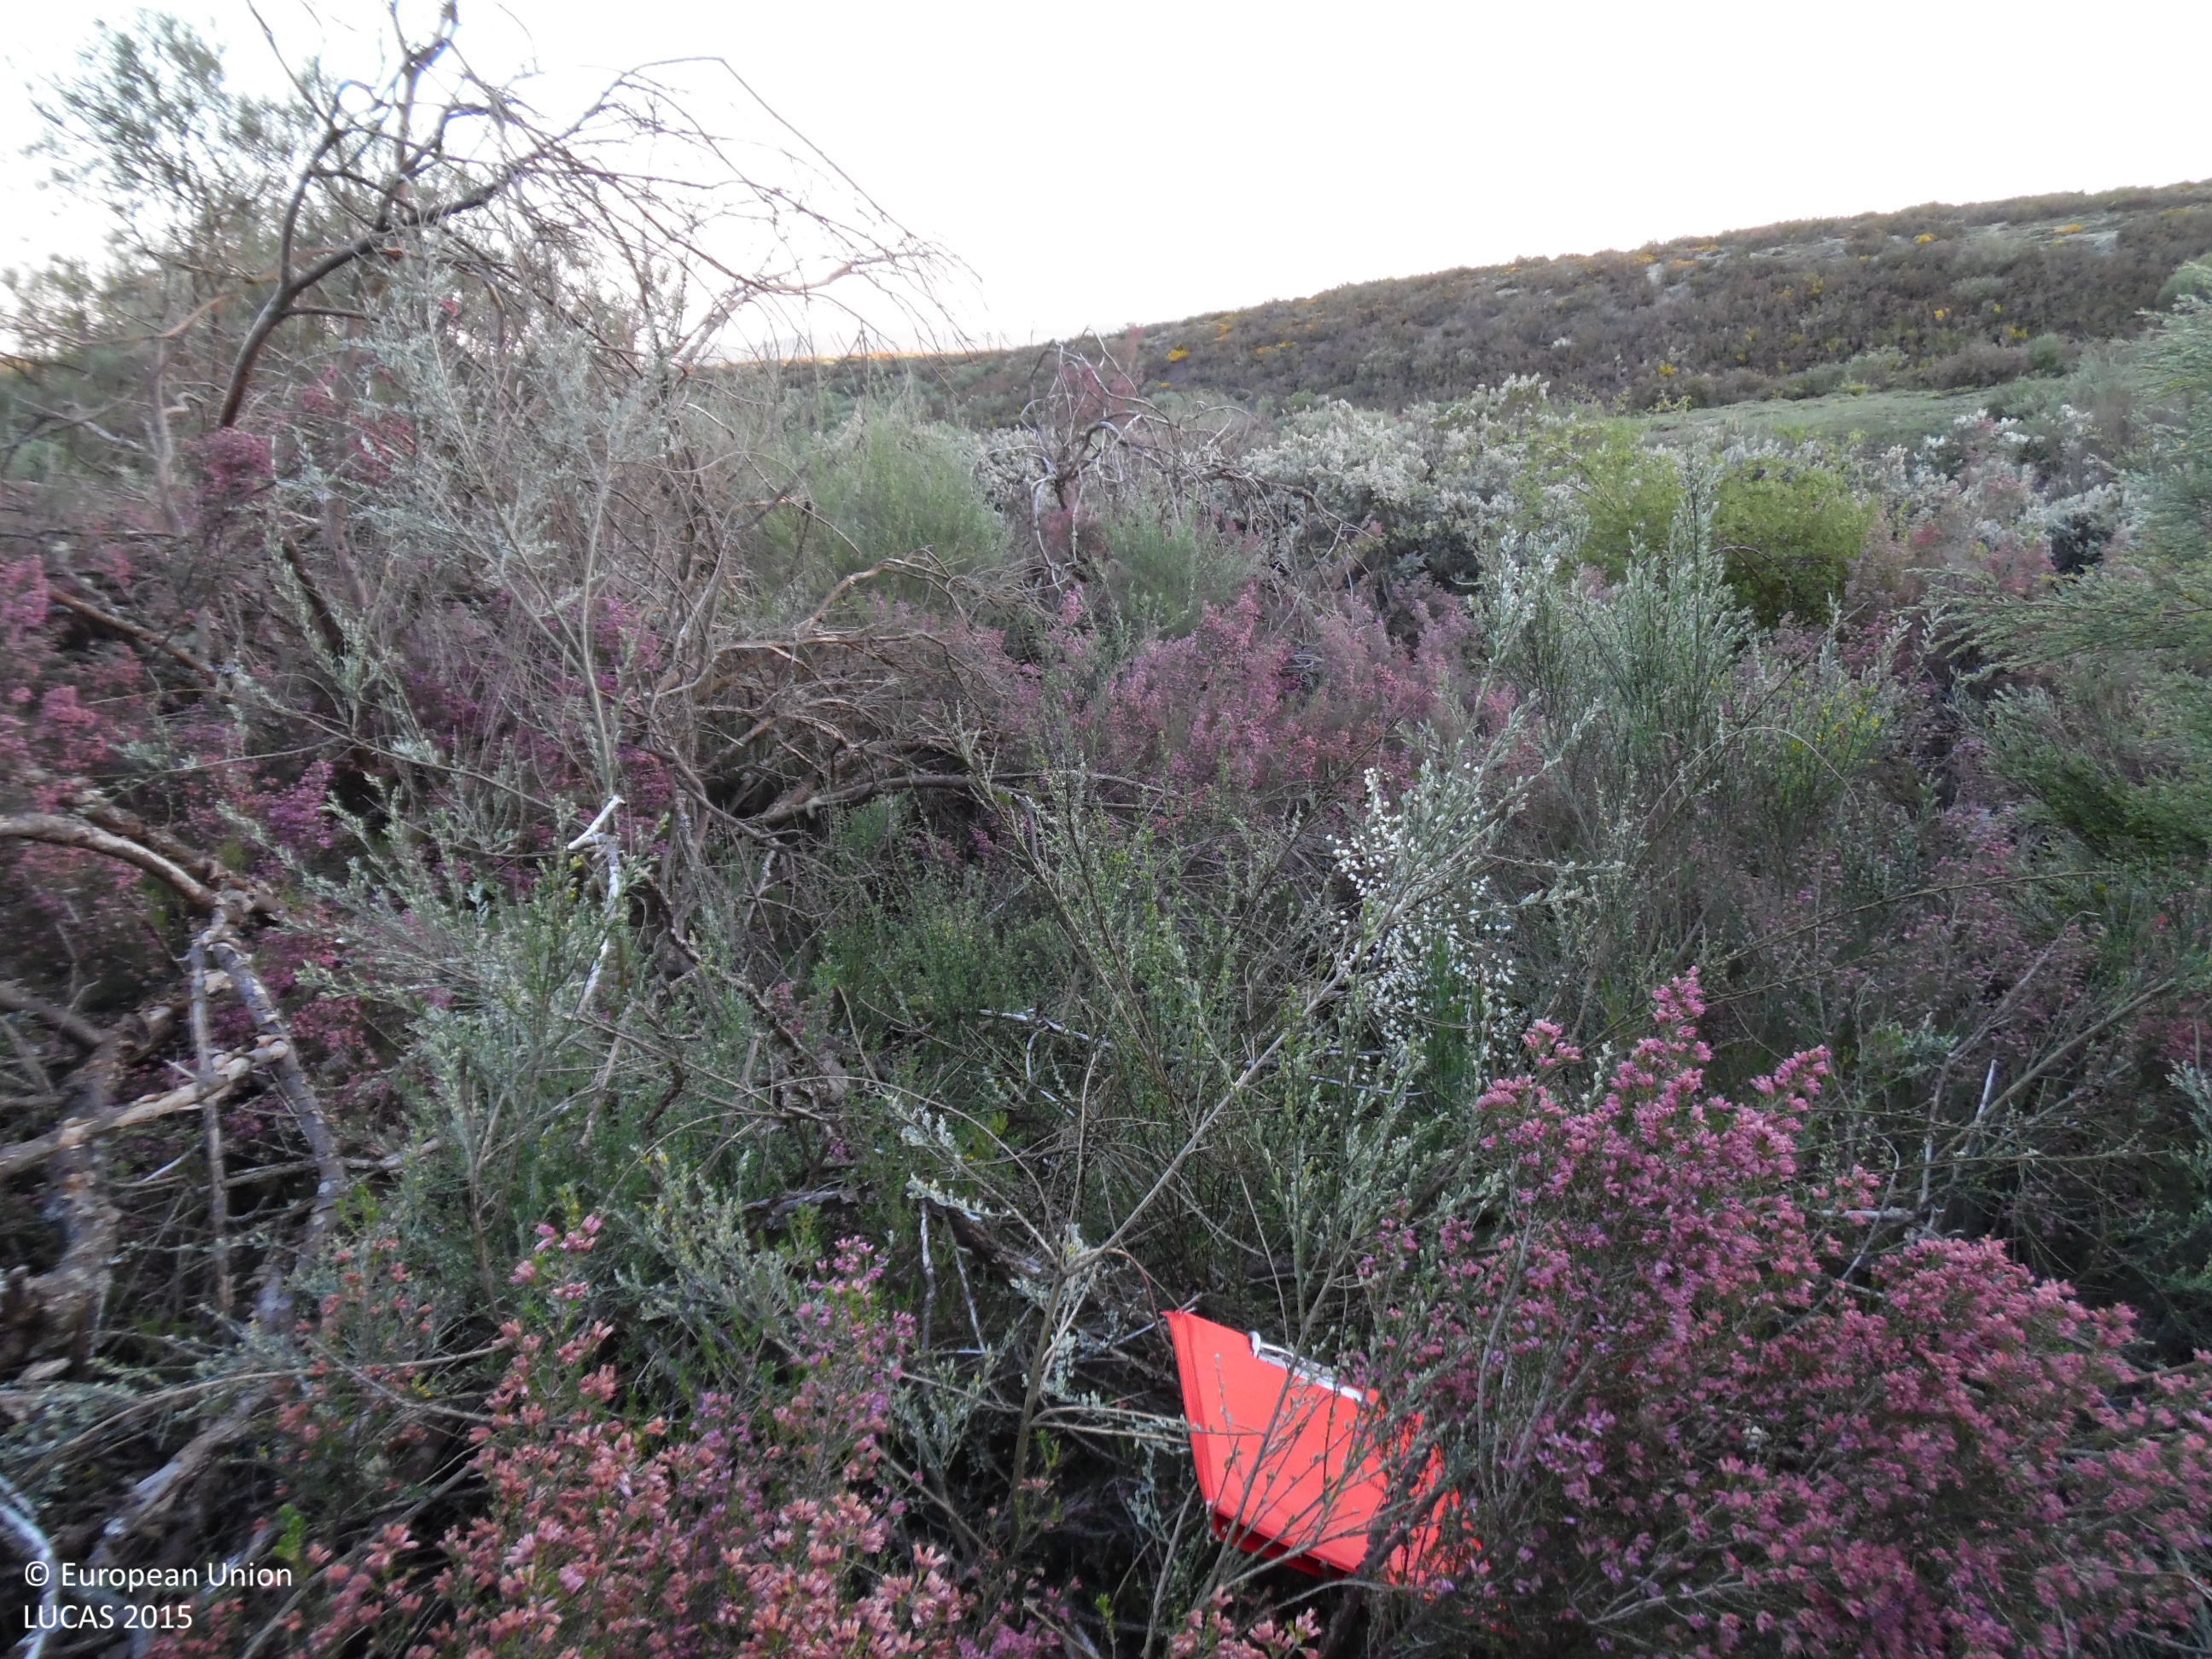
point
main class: Shrubland
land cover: Shrubland without tree cover
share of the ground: 50 - 75 %
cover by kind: shrubs 75 %, consolidated bare surface 25 %
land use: Semi-natural and natural areas not in use
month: May
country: ES
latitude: 42.6565
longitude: -6.1273
